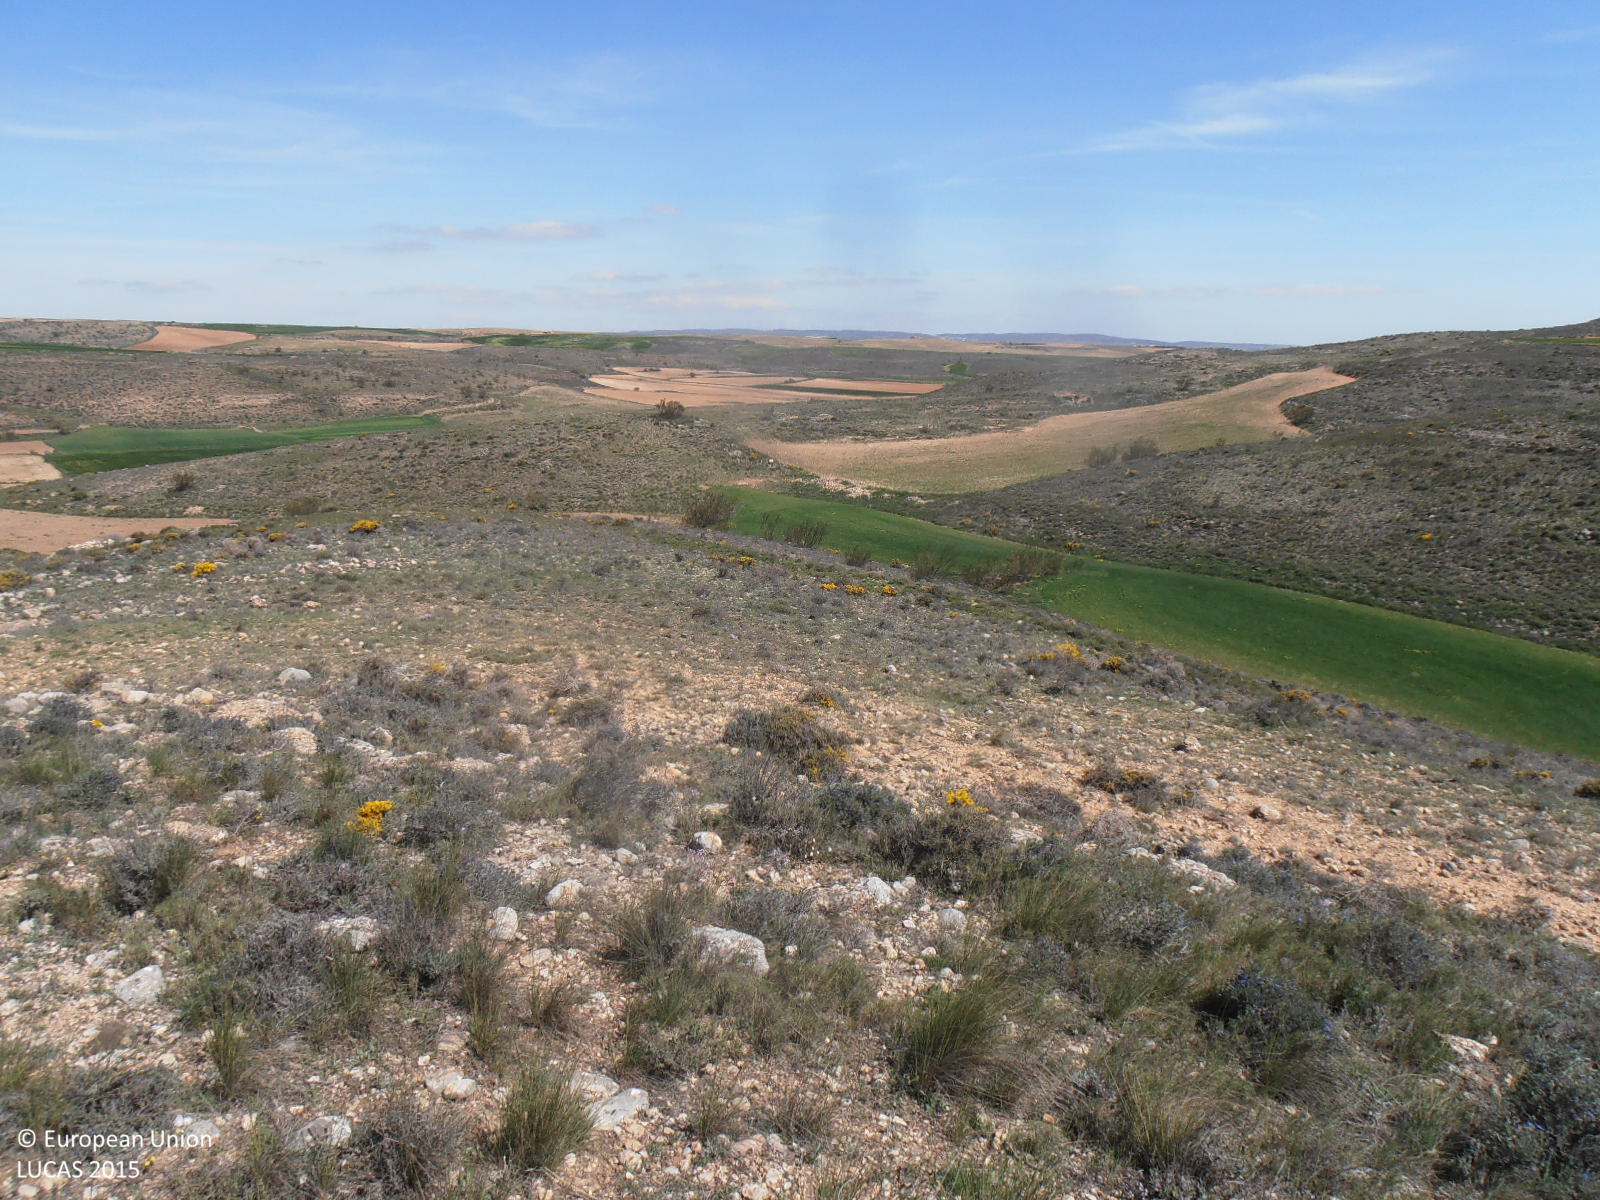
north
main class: Shrubland
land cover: Shrubland without tree cover
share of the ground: 50 - 75 %
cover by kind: shrubs 60 %, consolidated bare surface 30 %, herbaceous plants 10 %
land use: Semi-natural and natural areas not in use
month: April
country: ES
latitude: 41.2046
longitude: -0.9297
